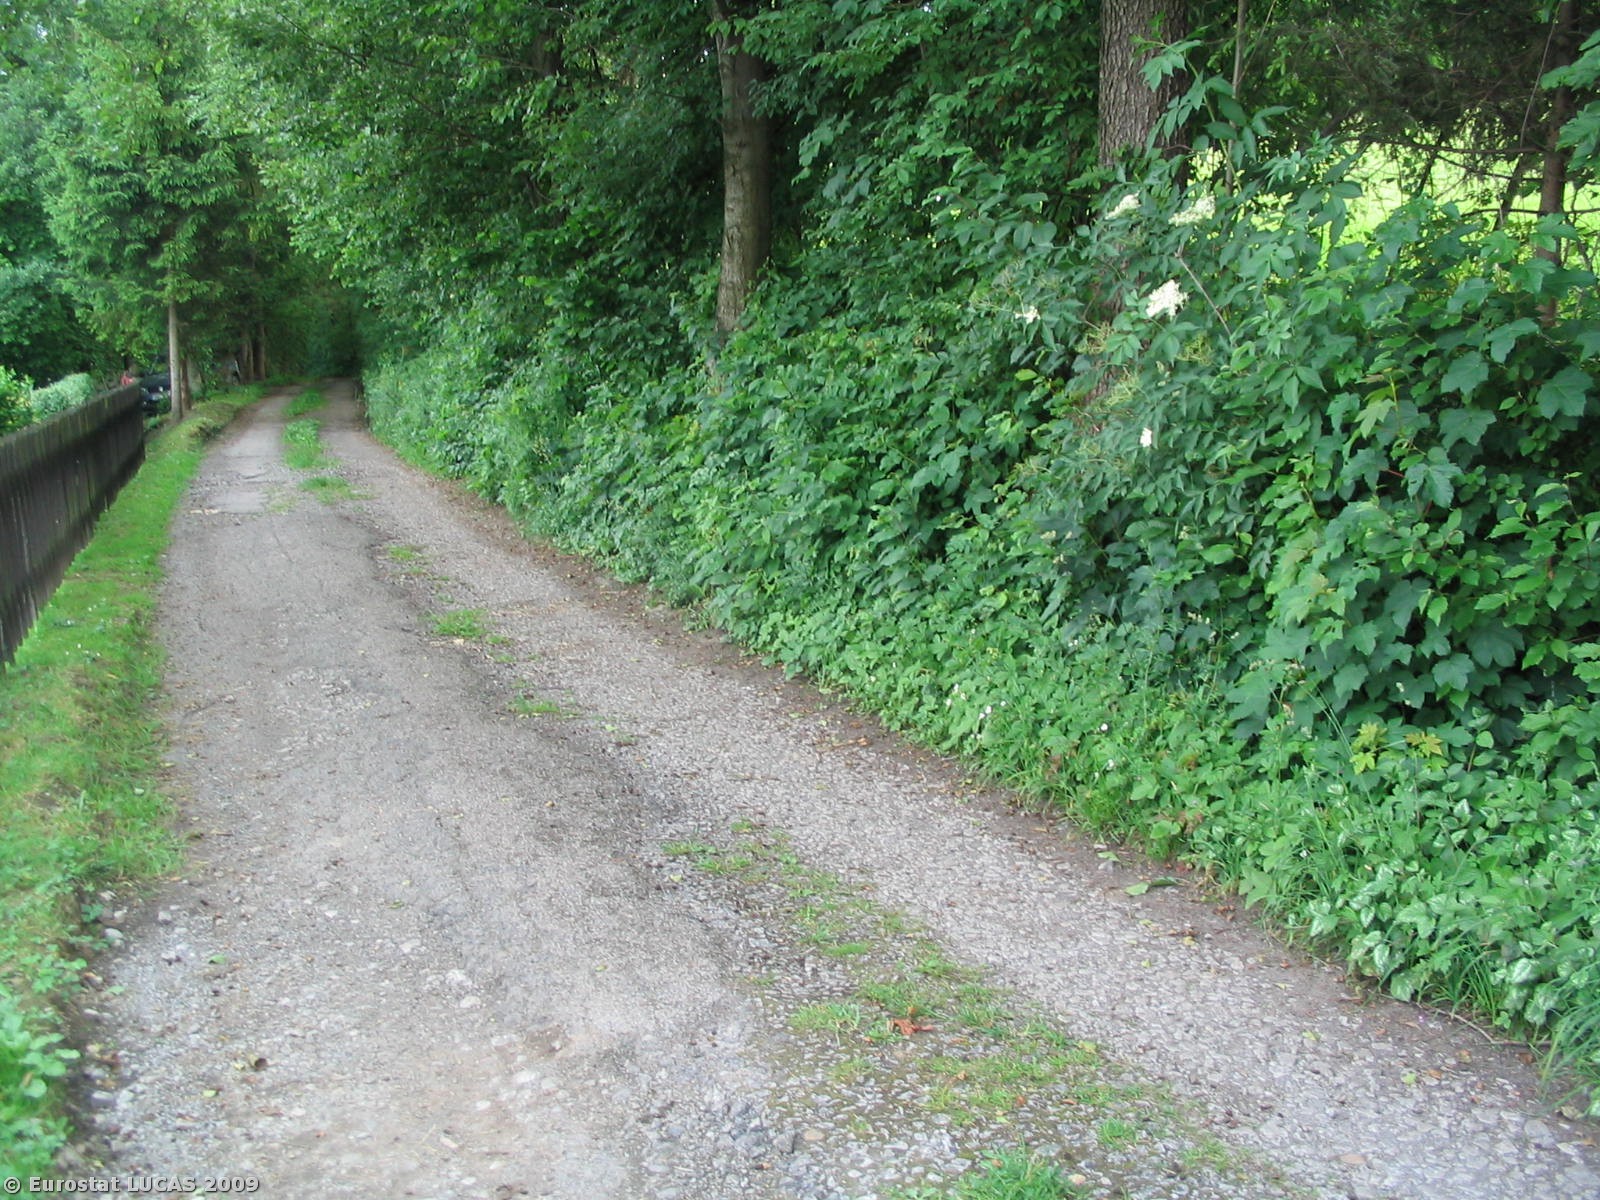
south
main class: Grassland
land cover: Grassland without tree/shrub cover
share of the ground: > 75 %
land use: Residential
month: June
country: CZ
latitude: 49.6654
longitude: 18.7630
